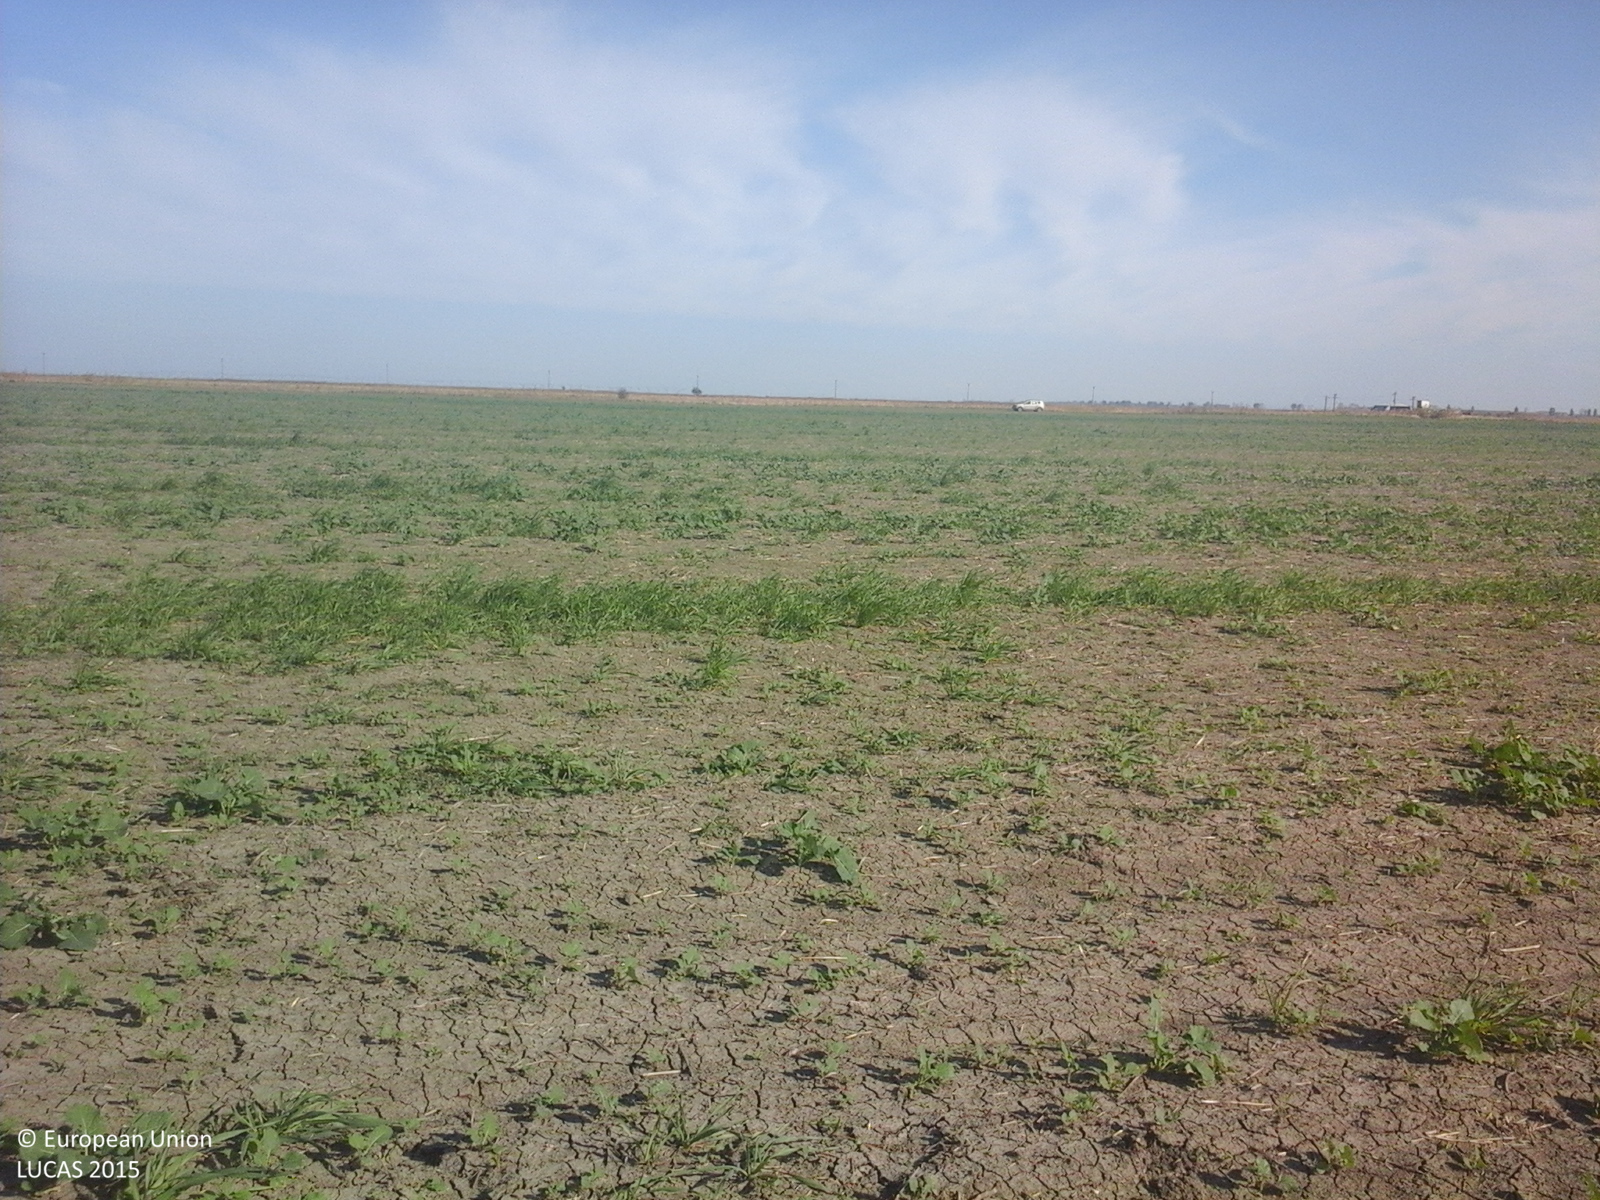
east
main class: Cropland
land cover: Common wheat
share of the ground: < 10 %
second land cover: Spontaneously vegetated surfaces
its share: 25 - 50 %
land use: Agriculture (excluding fallow land and kitchen gardens)
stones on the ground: < 10 %
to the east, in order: Common wheat; Spontaneously vegetated surfaces; Shruby margins; Ditches and canals; Maize
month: October
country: RO
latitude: 45.3369
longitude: 27.4937
